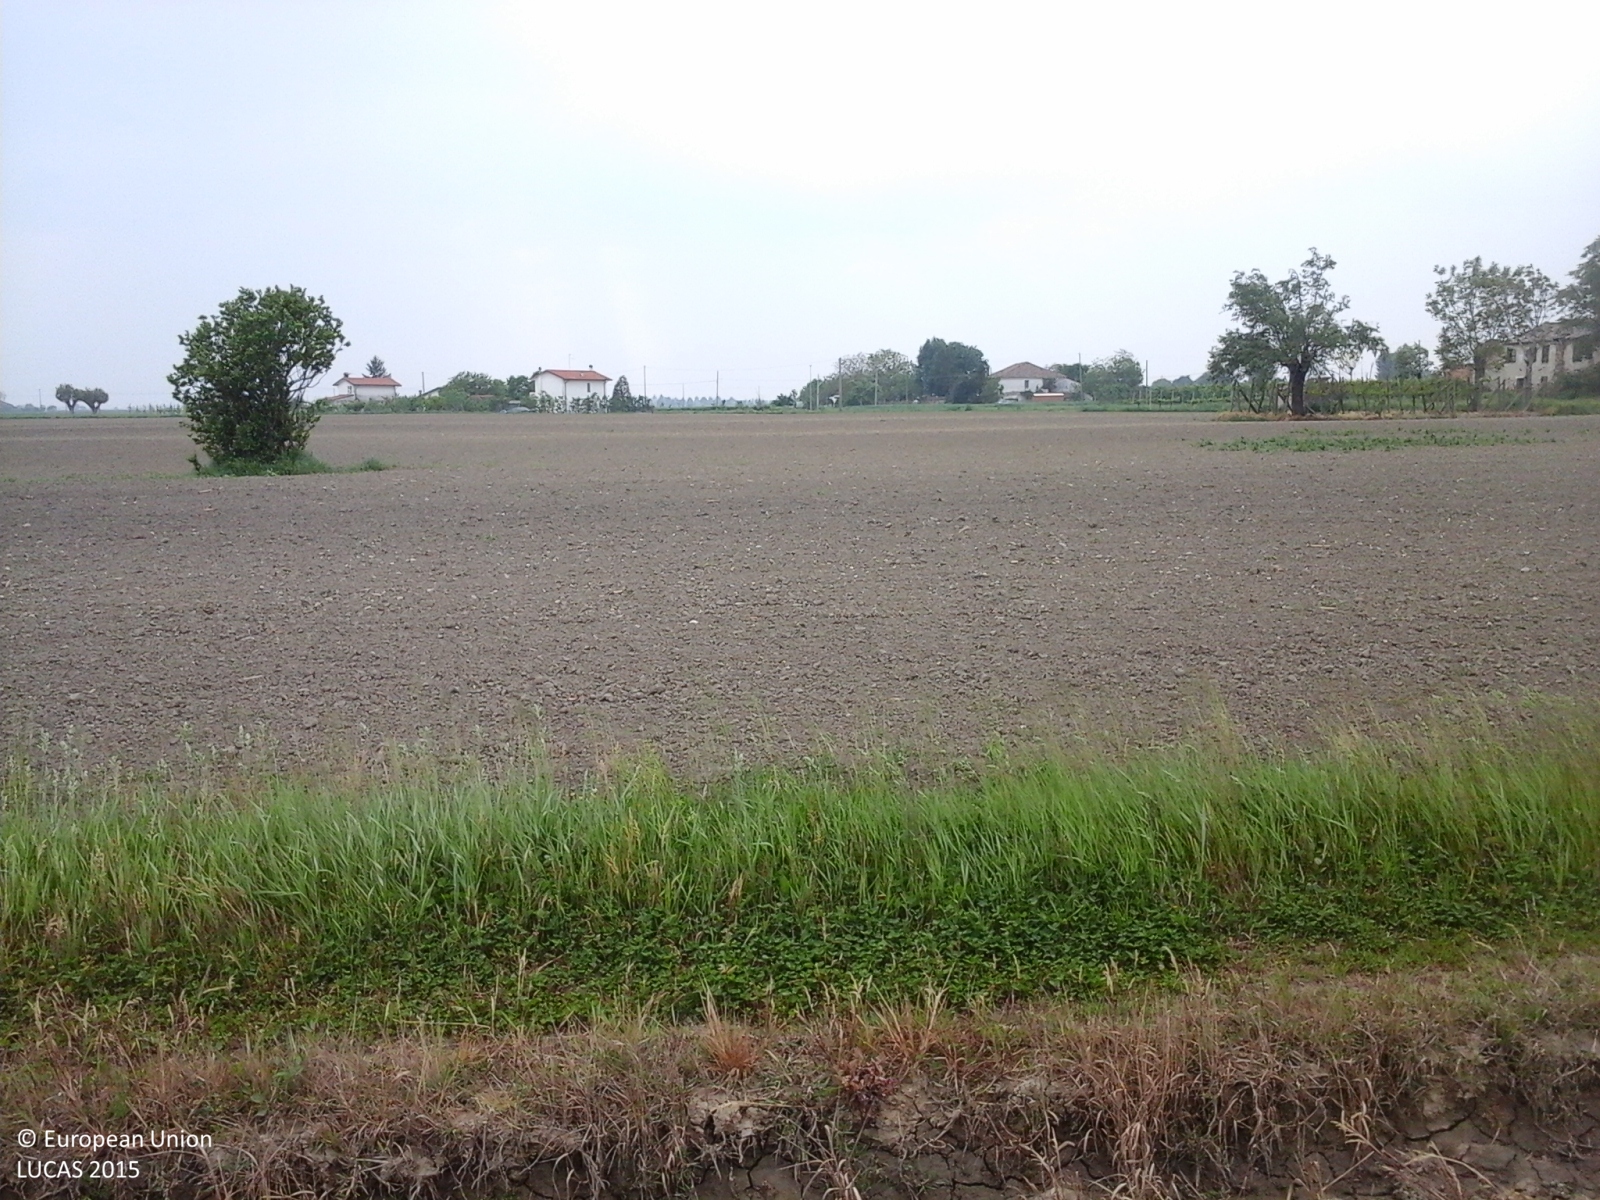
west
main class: Cropland
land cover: Soya
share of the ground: > 75 %
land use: Agriculture (excluding fallow land and kitchen gardens)
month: May
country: IT
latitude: 44.9701
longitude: 11.5566
